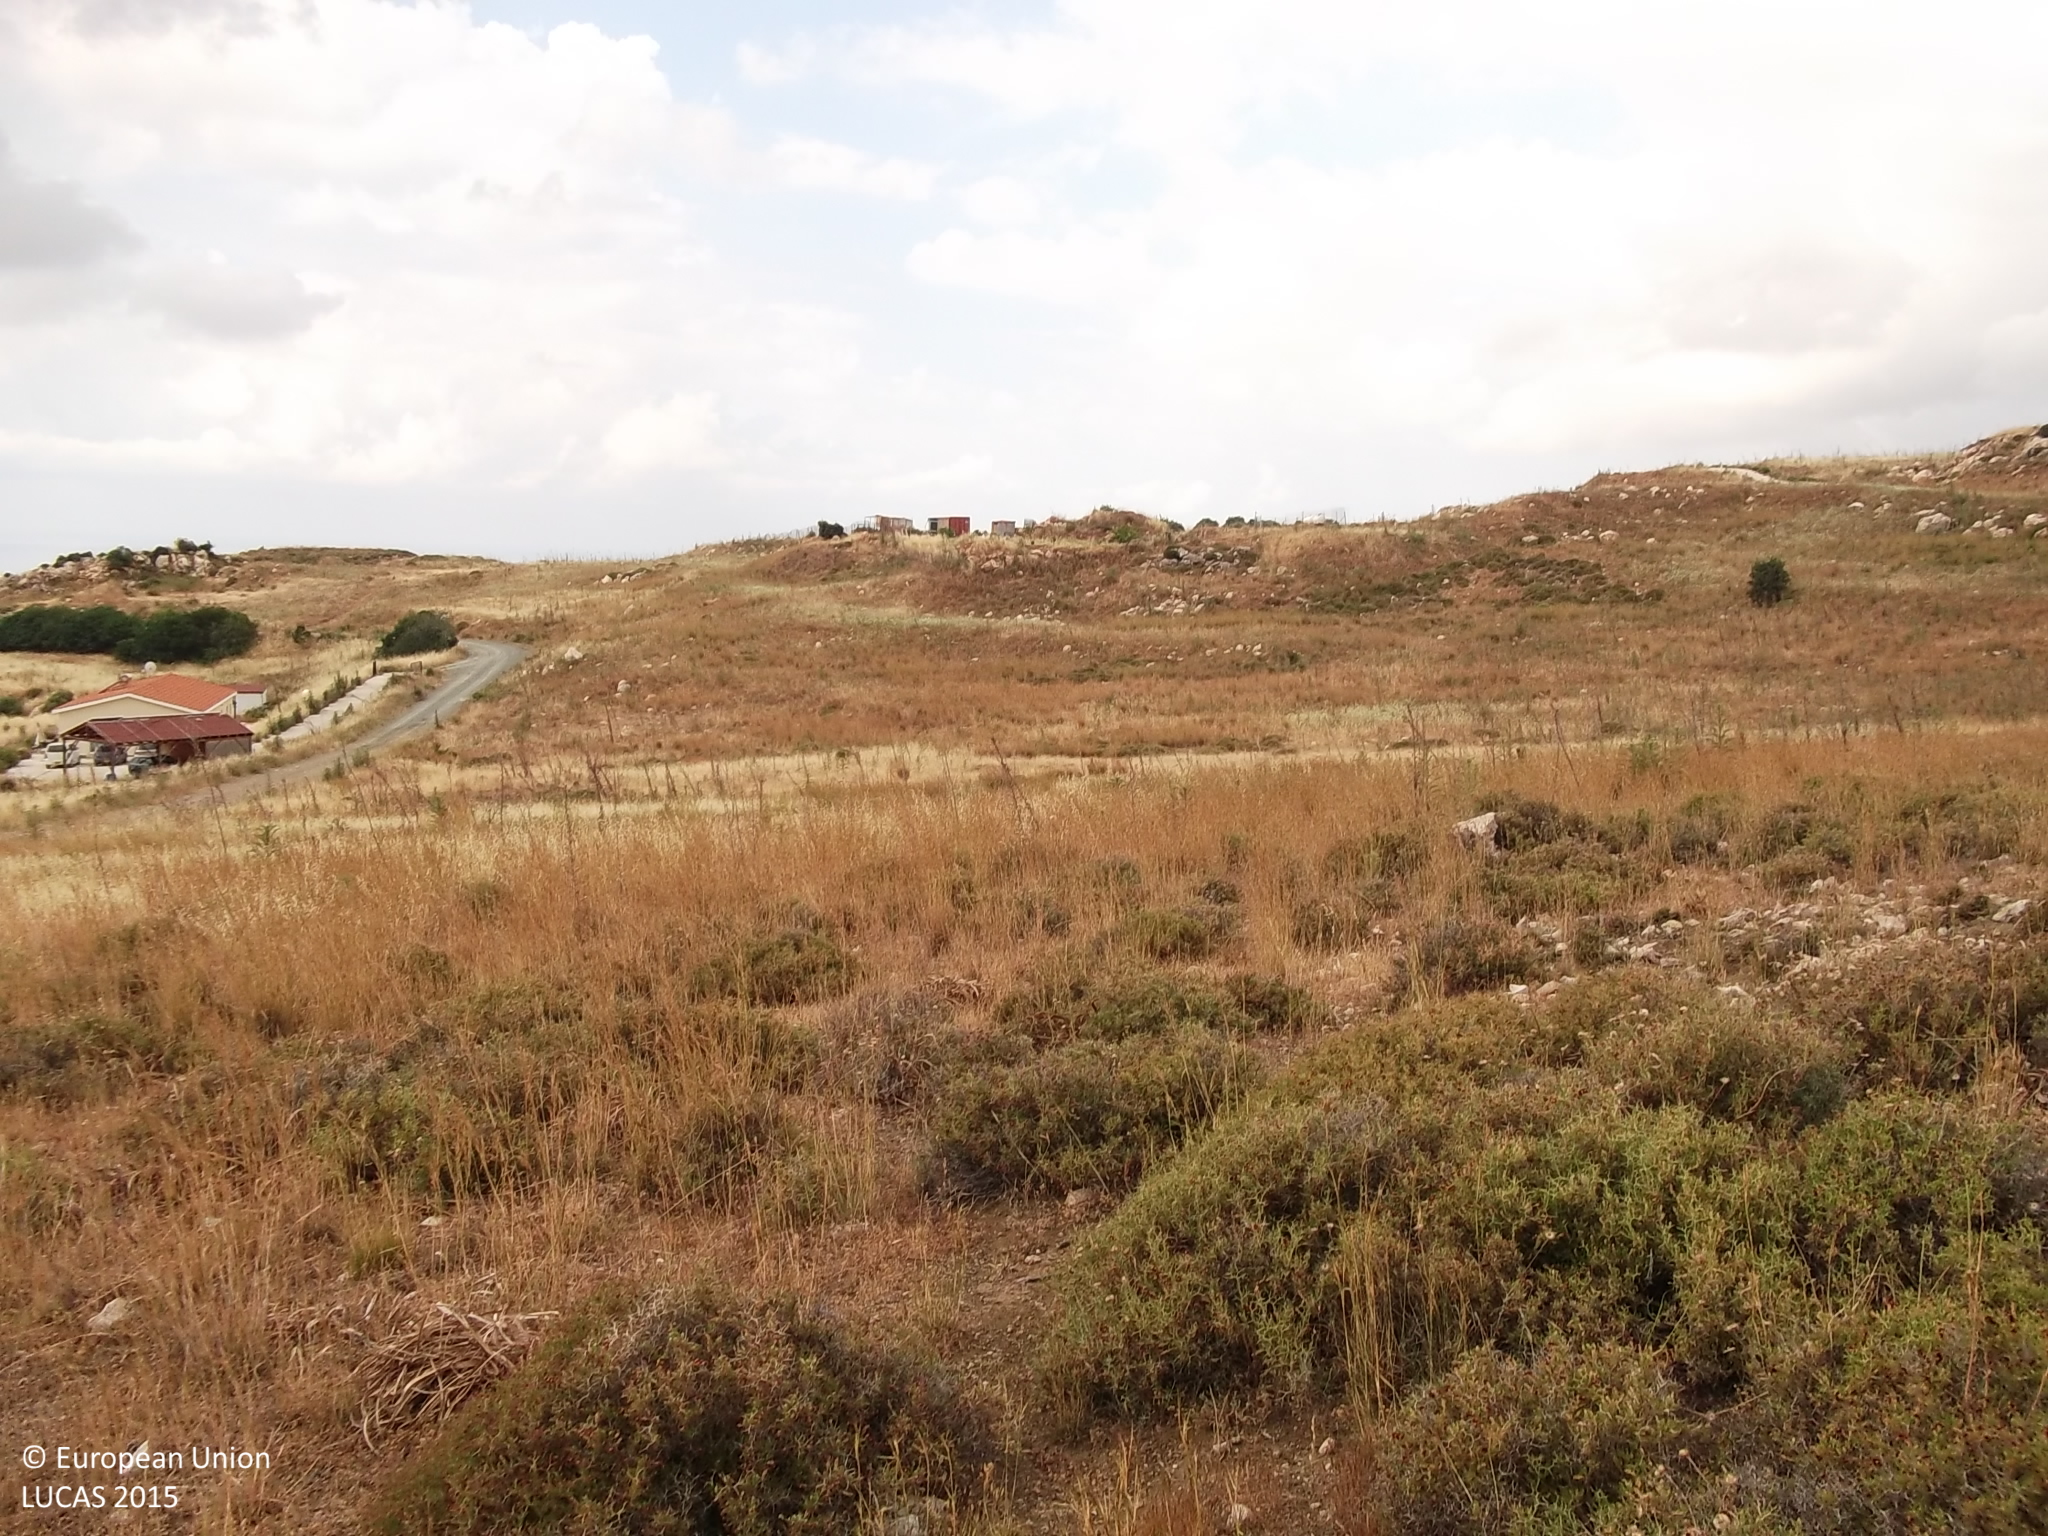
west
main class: Shrubland
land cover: Shrubland without tree cover
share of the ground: 25 - 50 %
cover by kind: herbaceous plants 50 %, shrubs 30 %, unconsolidated bare surface 20 %
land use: Semi-natural and natural areas not in use
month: May
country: CY
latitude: 34.7620
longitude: 32.5341
